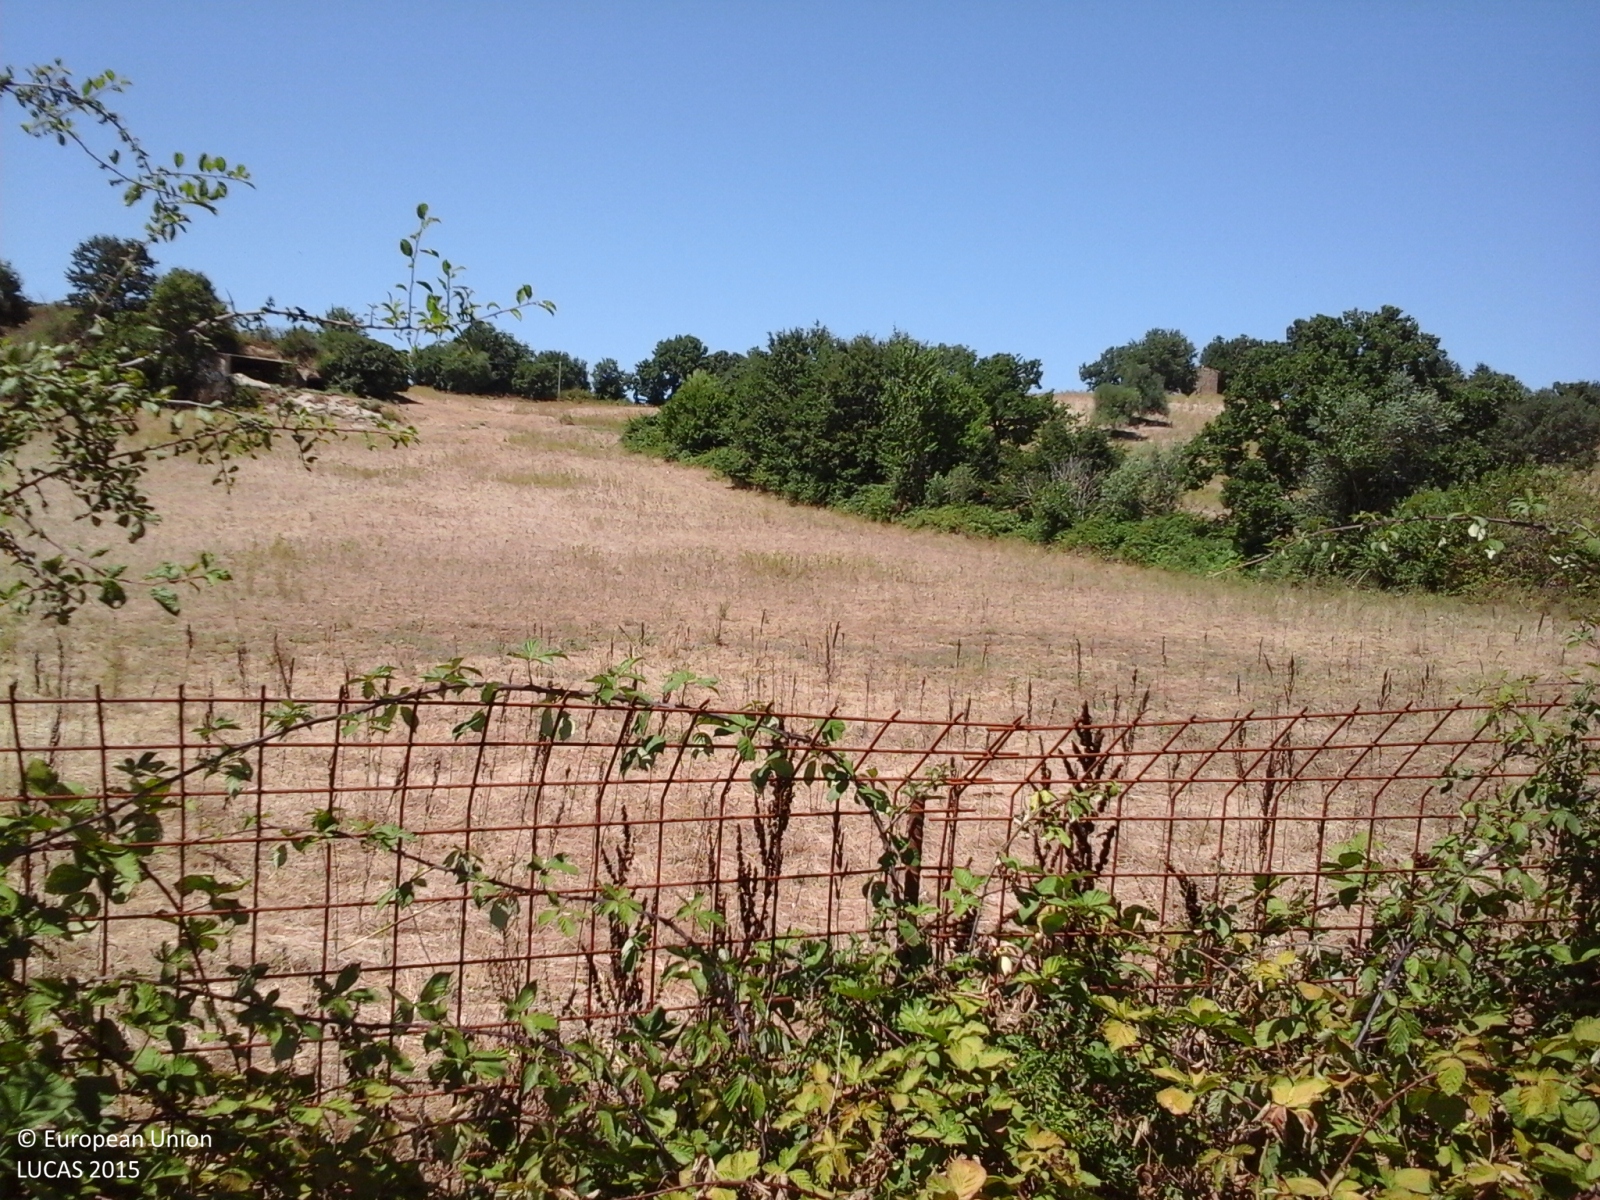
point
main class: Cropland
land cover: Temporary grasslands
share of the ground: > 75 %
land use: Agriculture (excluding fallow land and kitchen gardens)
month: August
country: IT
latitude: 42.6415
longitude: 11.5924
